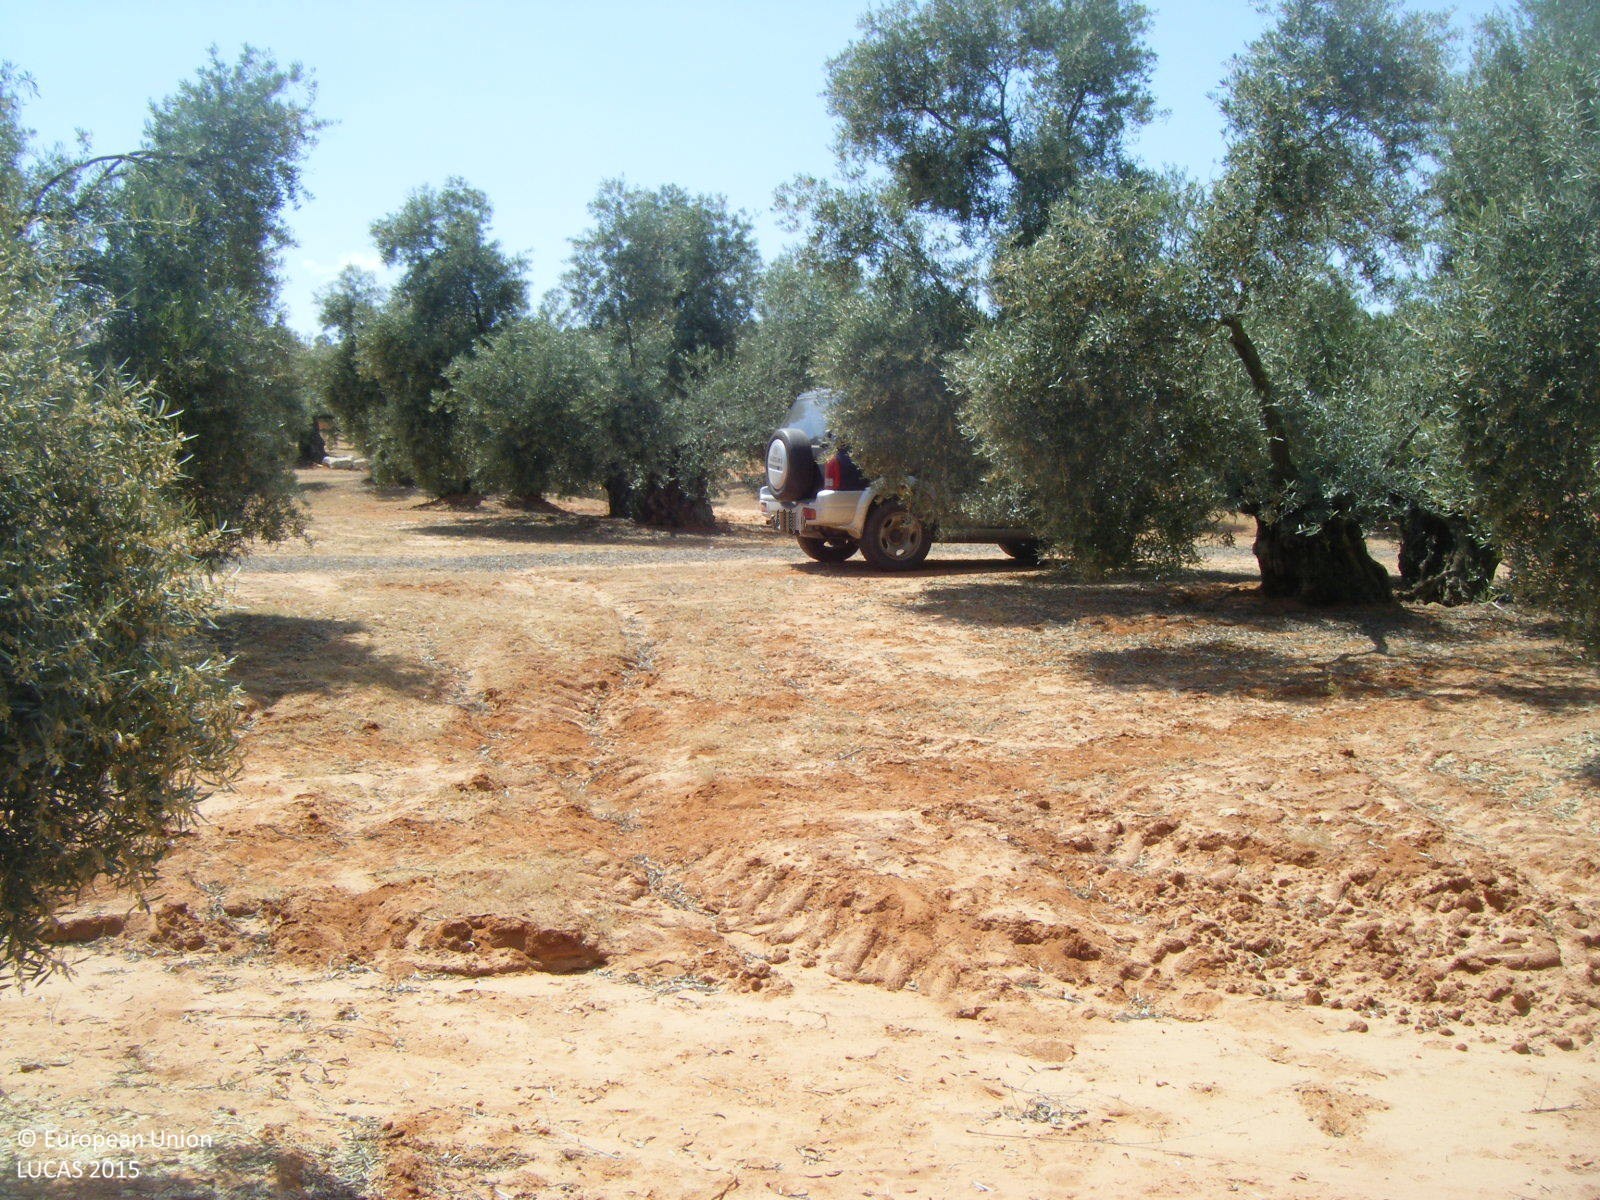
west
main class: Cropland
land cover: Olive groves
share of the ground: 10 - 25 %
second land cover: Other bare soil
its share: > 75 %
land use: Agriculture (excluding fallow land and kitchen gardens)
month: May
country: ES
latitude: 37.2144
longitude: -4.5251
